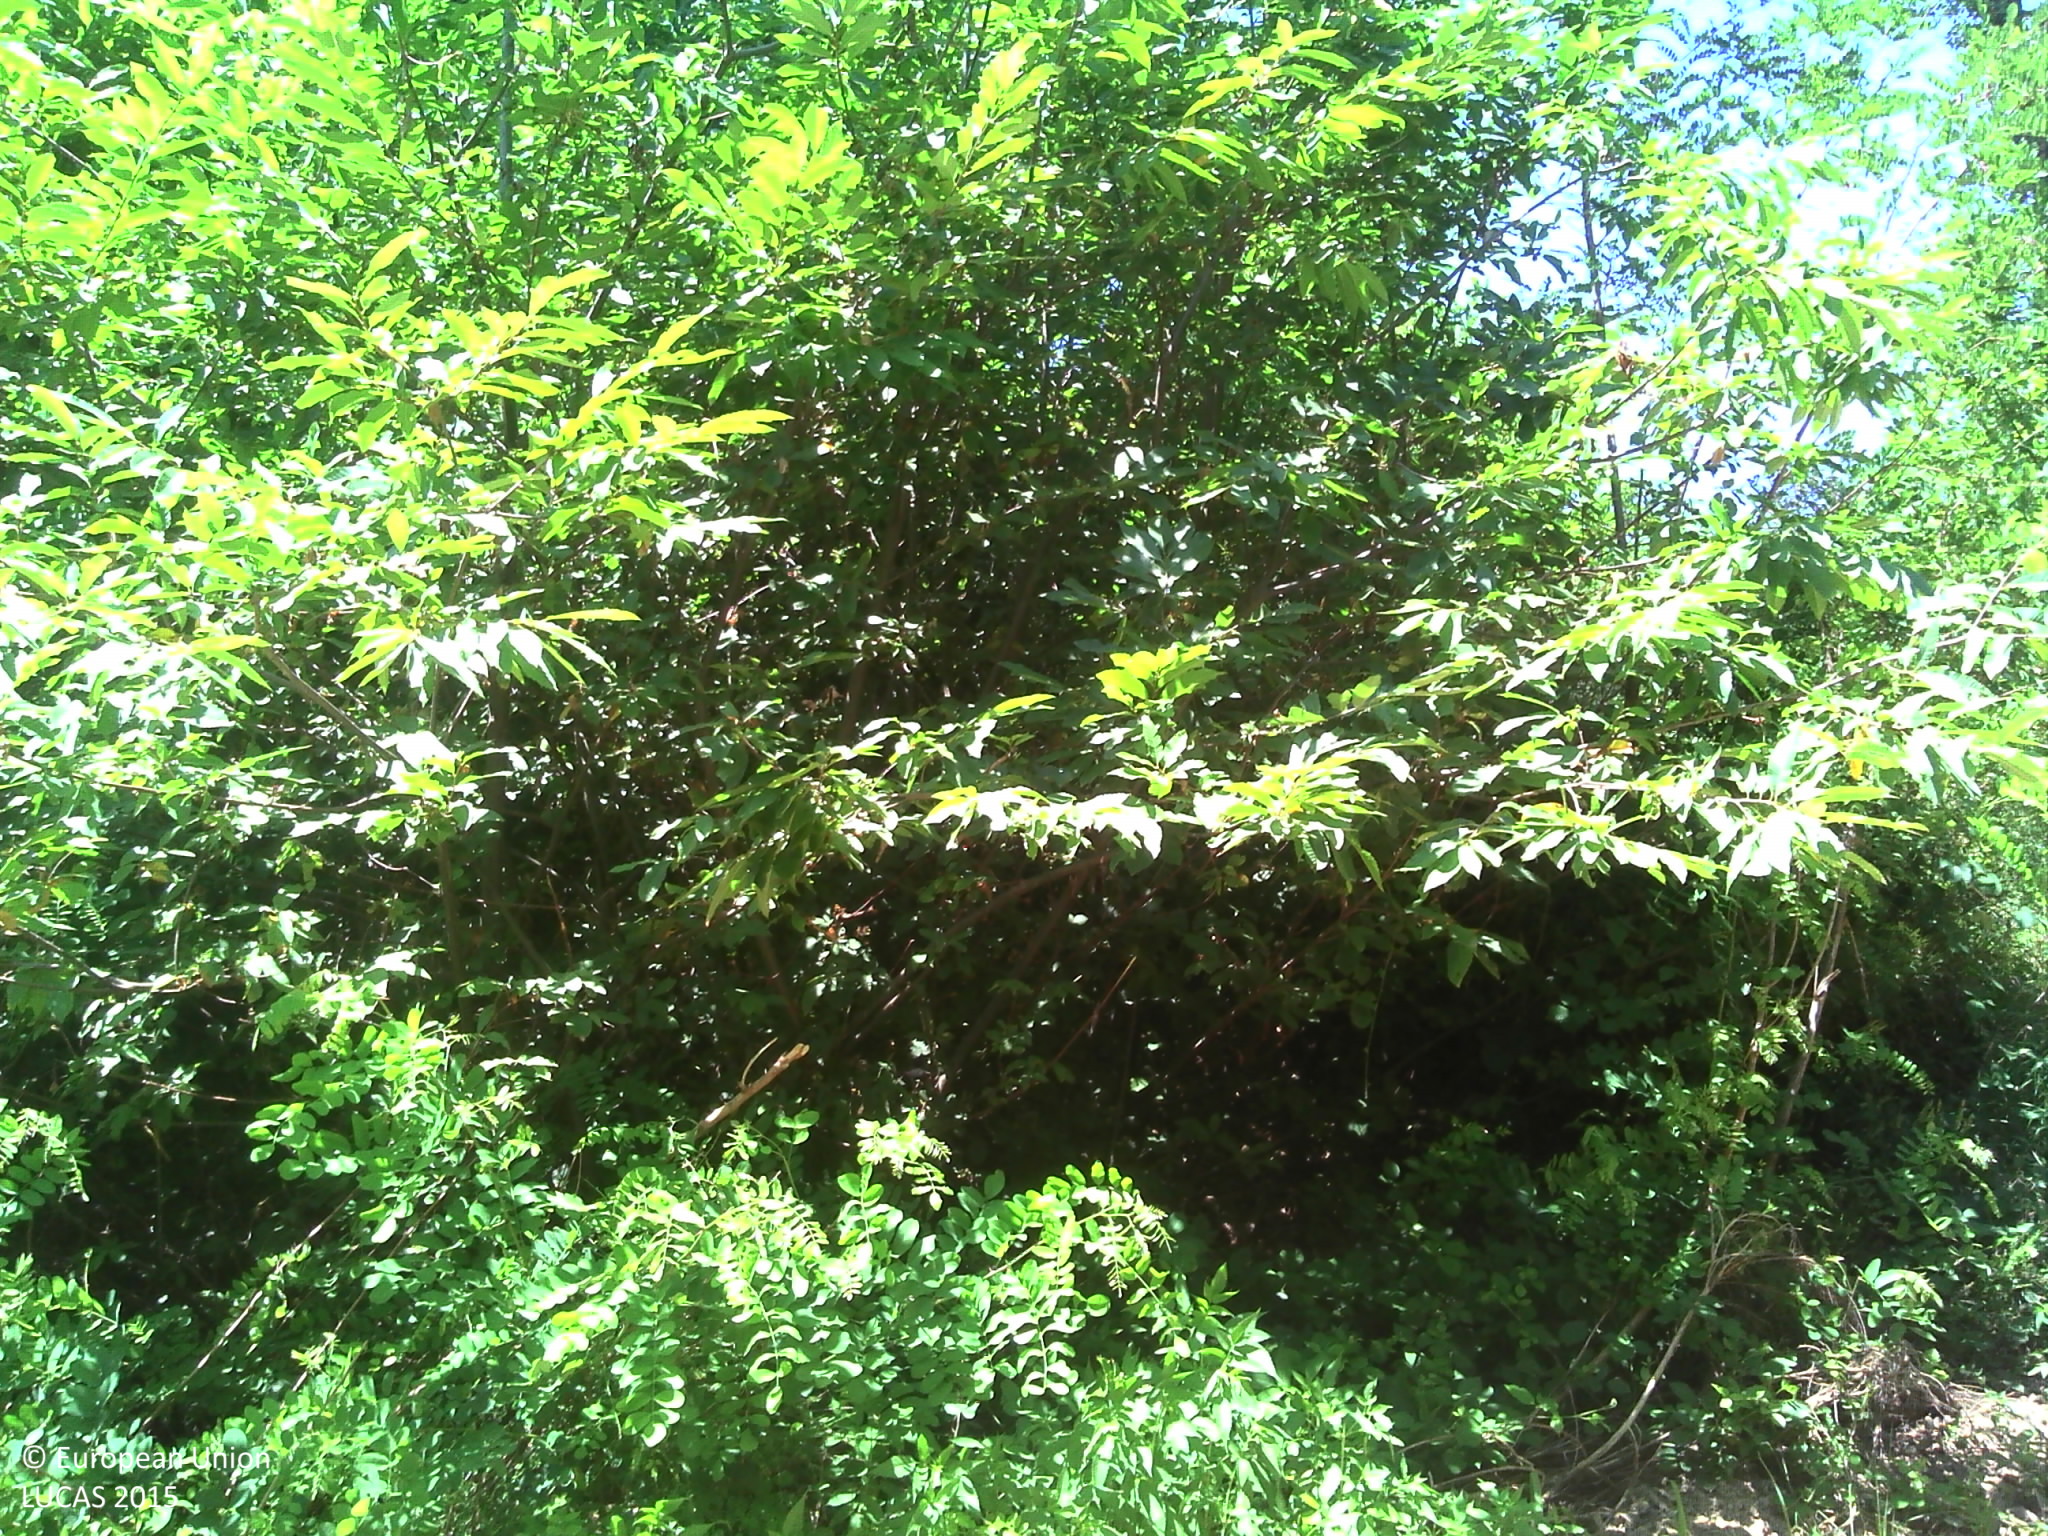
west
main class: Woodland
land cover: Broadleaved woodland
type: mesophytic deciduous forest
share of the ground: > 75 %
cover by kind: broadleaved forest trees 100 %
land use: Forestry
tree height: > 5 m
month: July
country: FR
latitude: 45.1598
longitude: 5.1839
